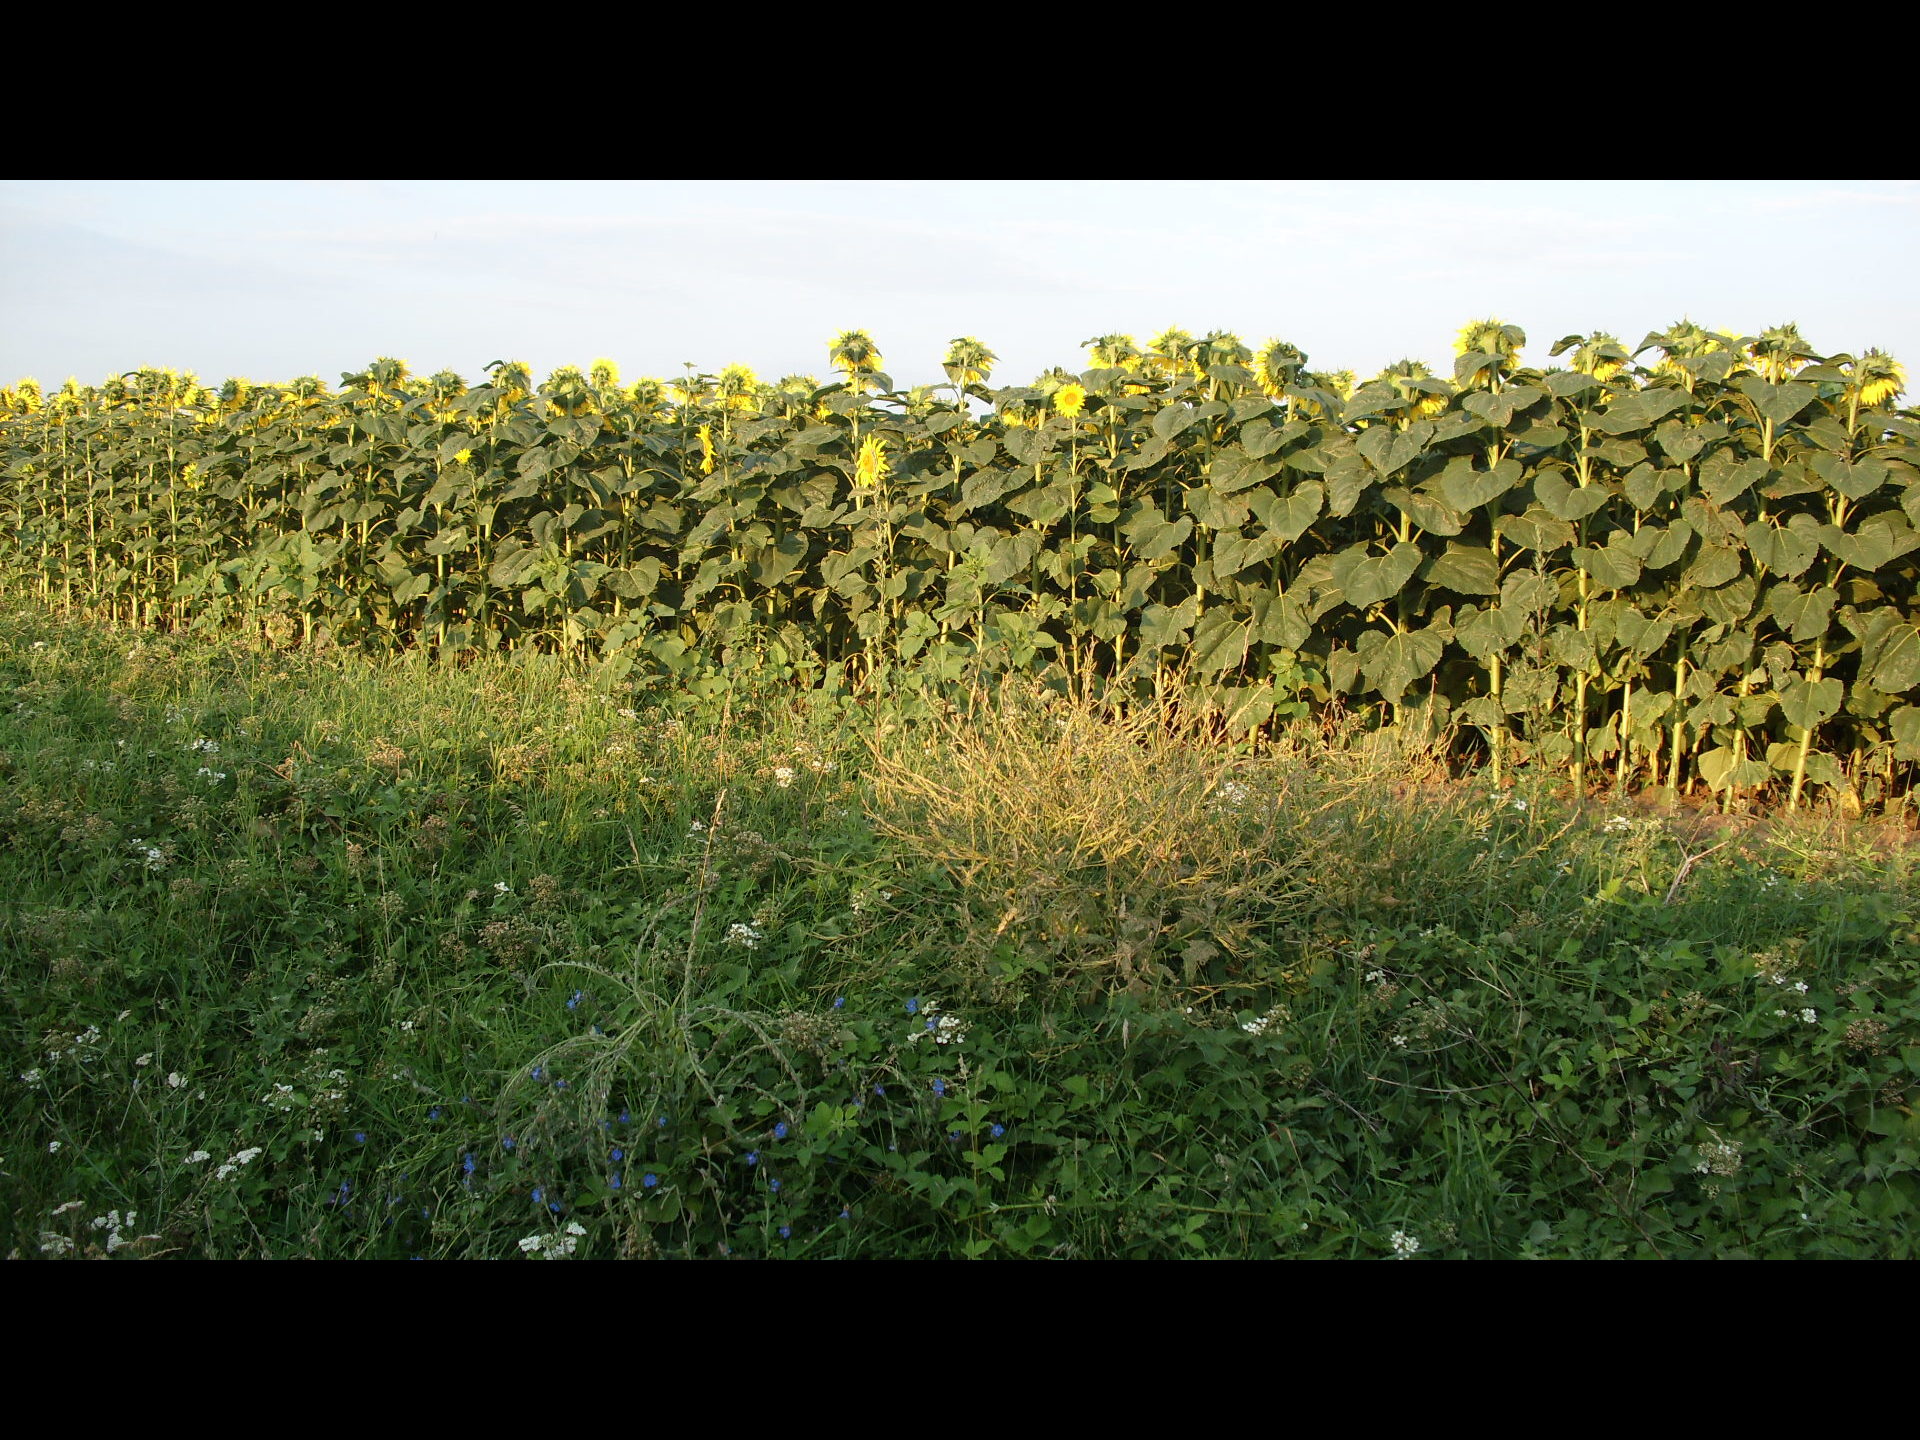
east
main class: Cropland
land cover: Sunflower
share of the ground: > 75 %
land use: Agriculture (excluding fallow land and kitchen gardens)
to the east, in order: Sunflower; Grass margins; Tracks; Grassland without tree/shrub cover; Sunflower
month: July
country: BG
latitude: 43.7238
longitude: 23.1877
